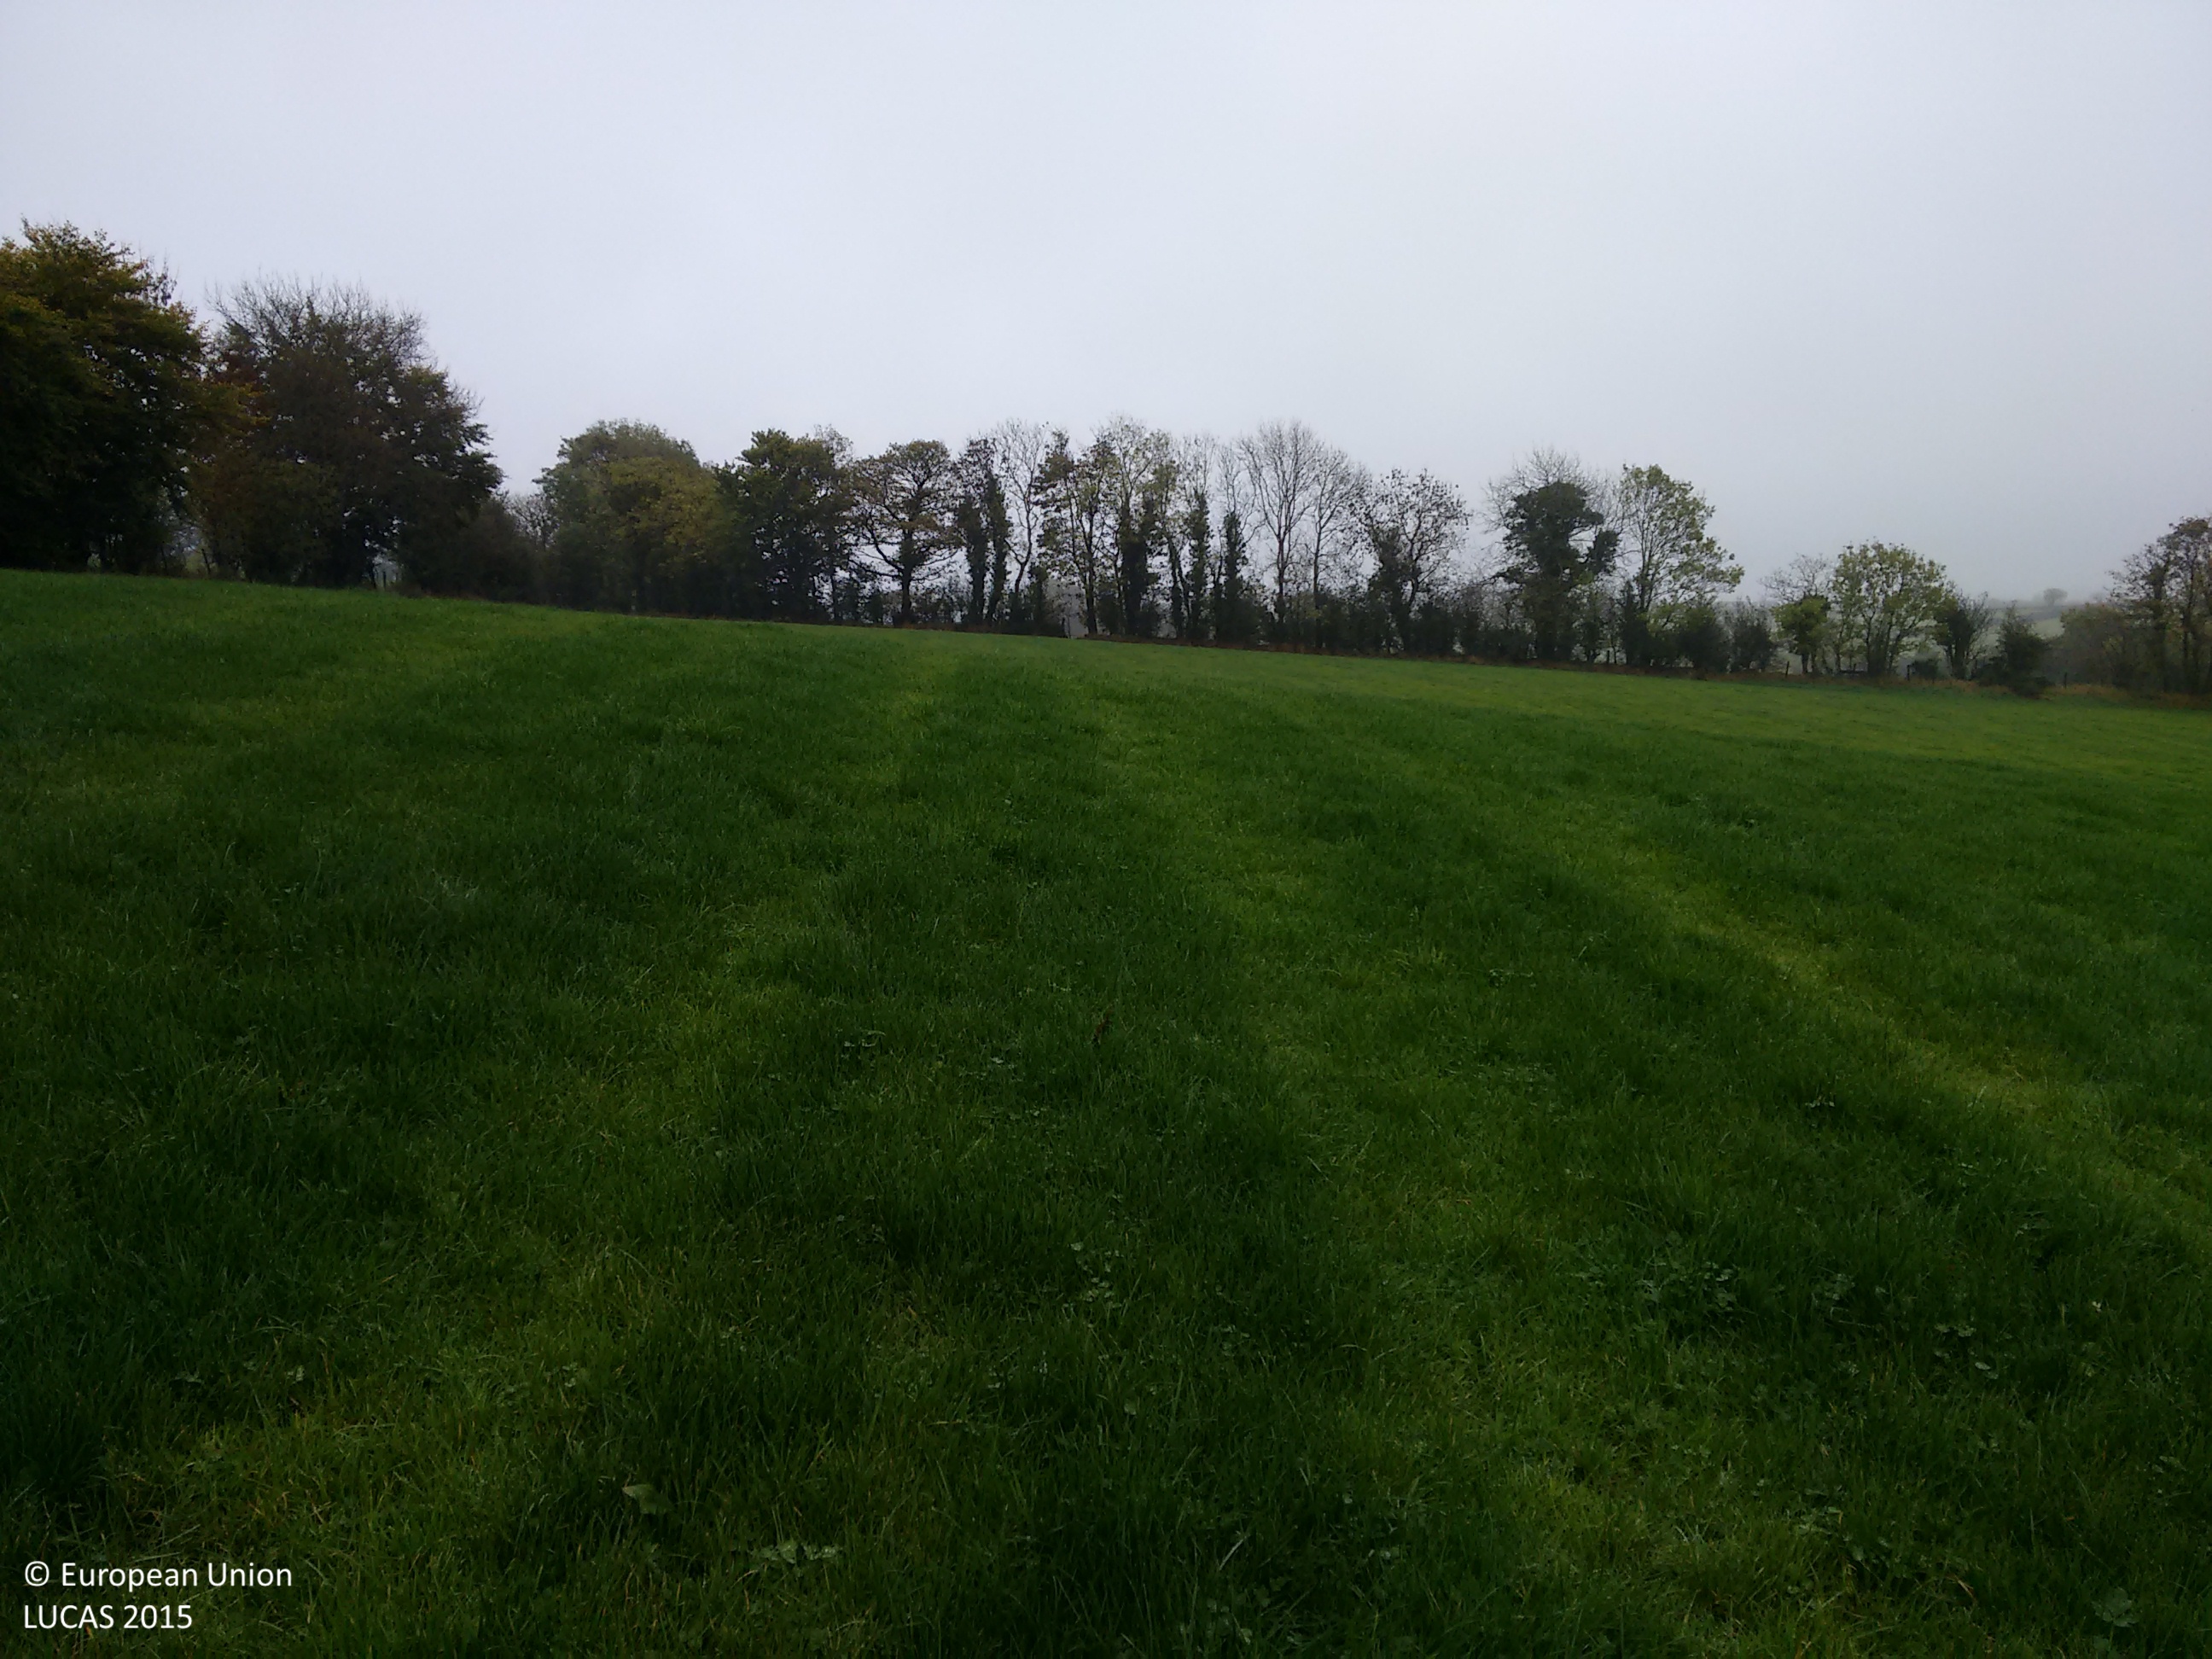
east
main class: Grassland
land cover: Grassland without tree/shrub cover
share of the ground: > 75 %
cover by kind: herbaceous plants 100 %
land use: Agriculture (excluding fallow land and kitchen gardens)
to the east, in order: Grassland without tree/shrub cover; Fences; Abandoned hedges; Grassland without tree/shrub cover; Fences; Abandoned hedges
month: October
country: GB
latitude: 54.5568
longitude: -7.4251
